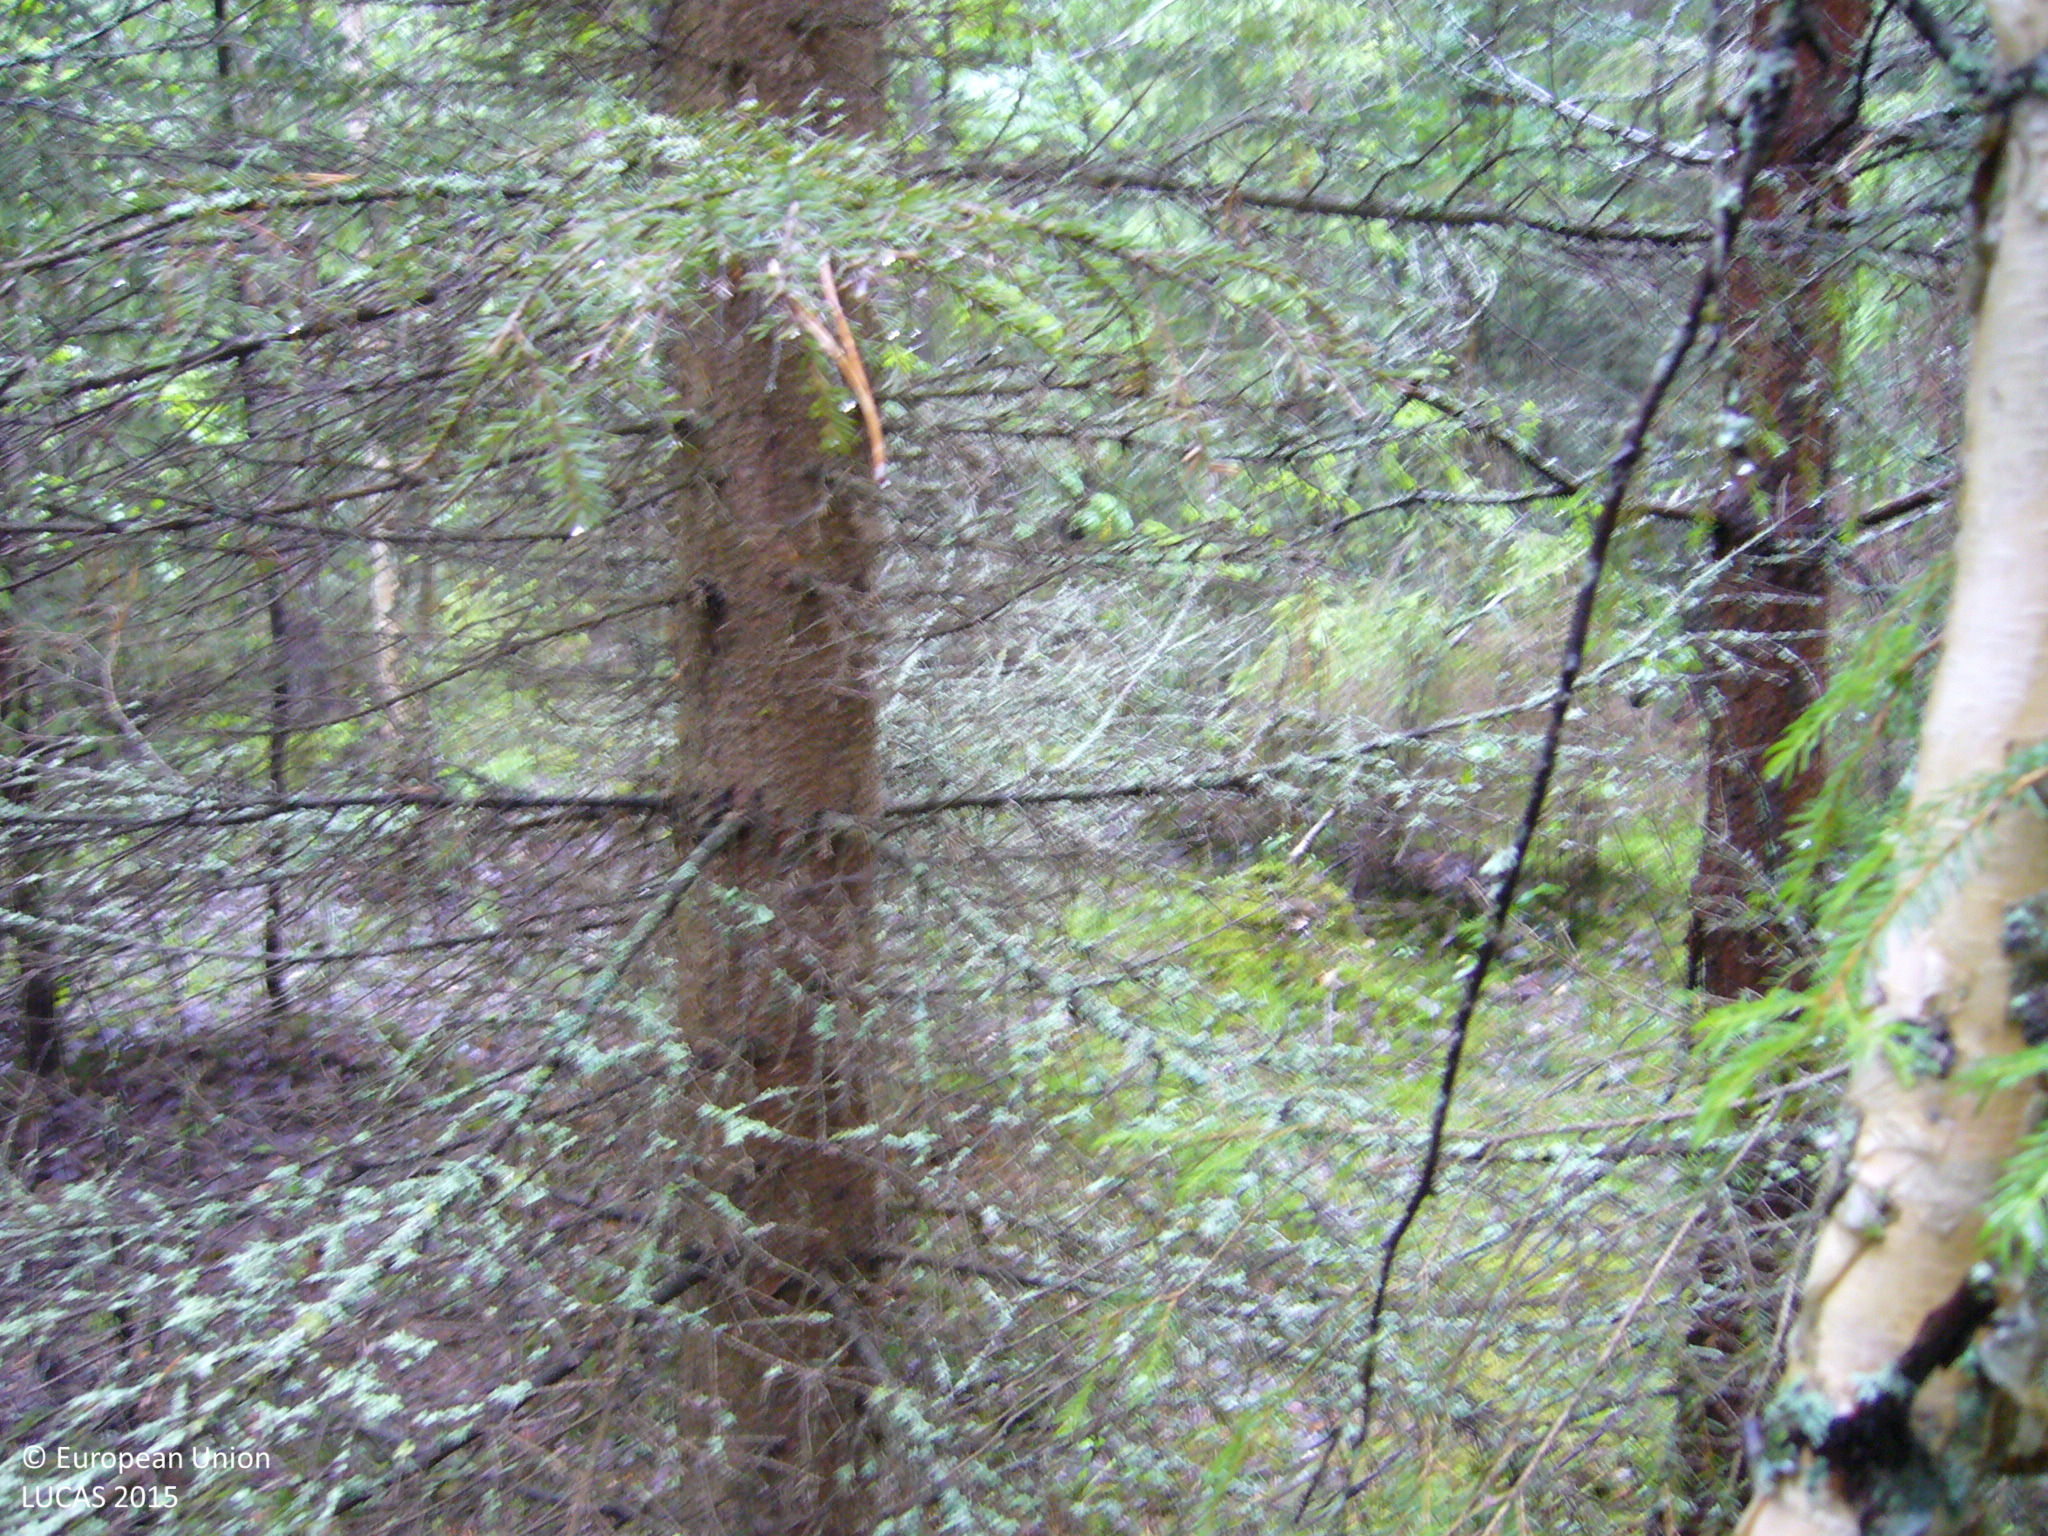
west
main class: Woodland
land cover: Spruce dominated mixed woodland
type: boreal forest
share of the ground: > 75 %
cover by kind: coniferous forest trees 65 %, broadleaved forest trees 30 %, shrubs 5 %
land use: Forestry
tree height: > 5 m
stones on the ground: < 10 %
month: June
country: FI
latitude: 63.6969
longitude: 26.2800
